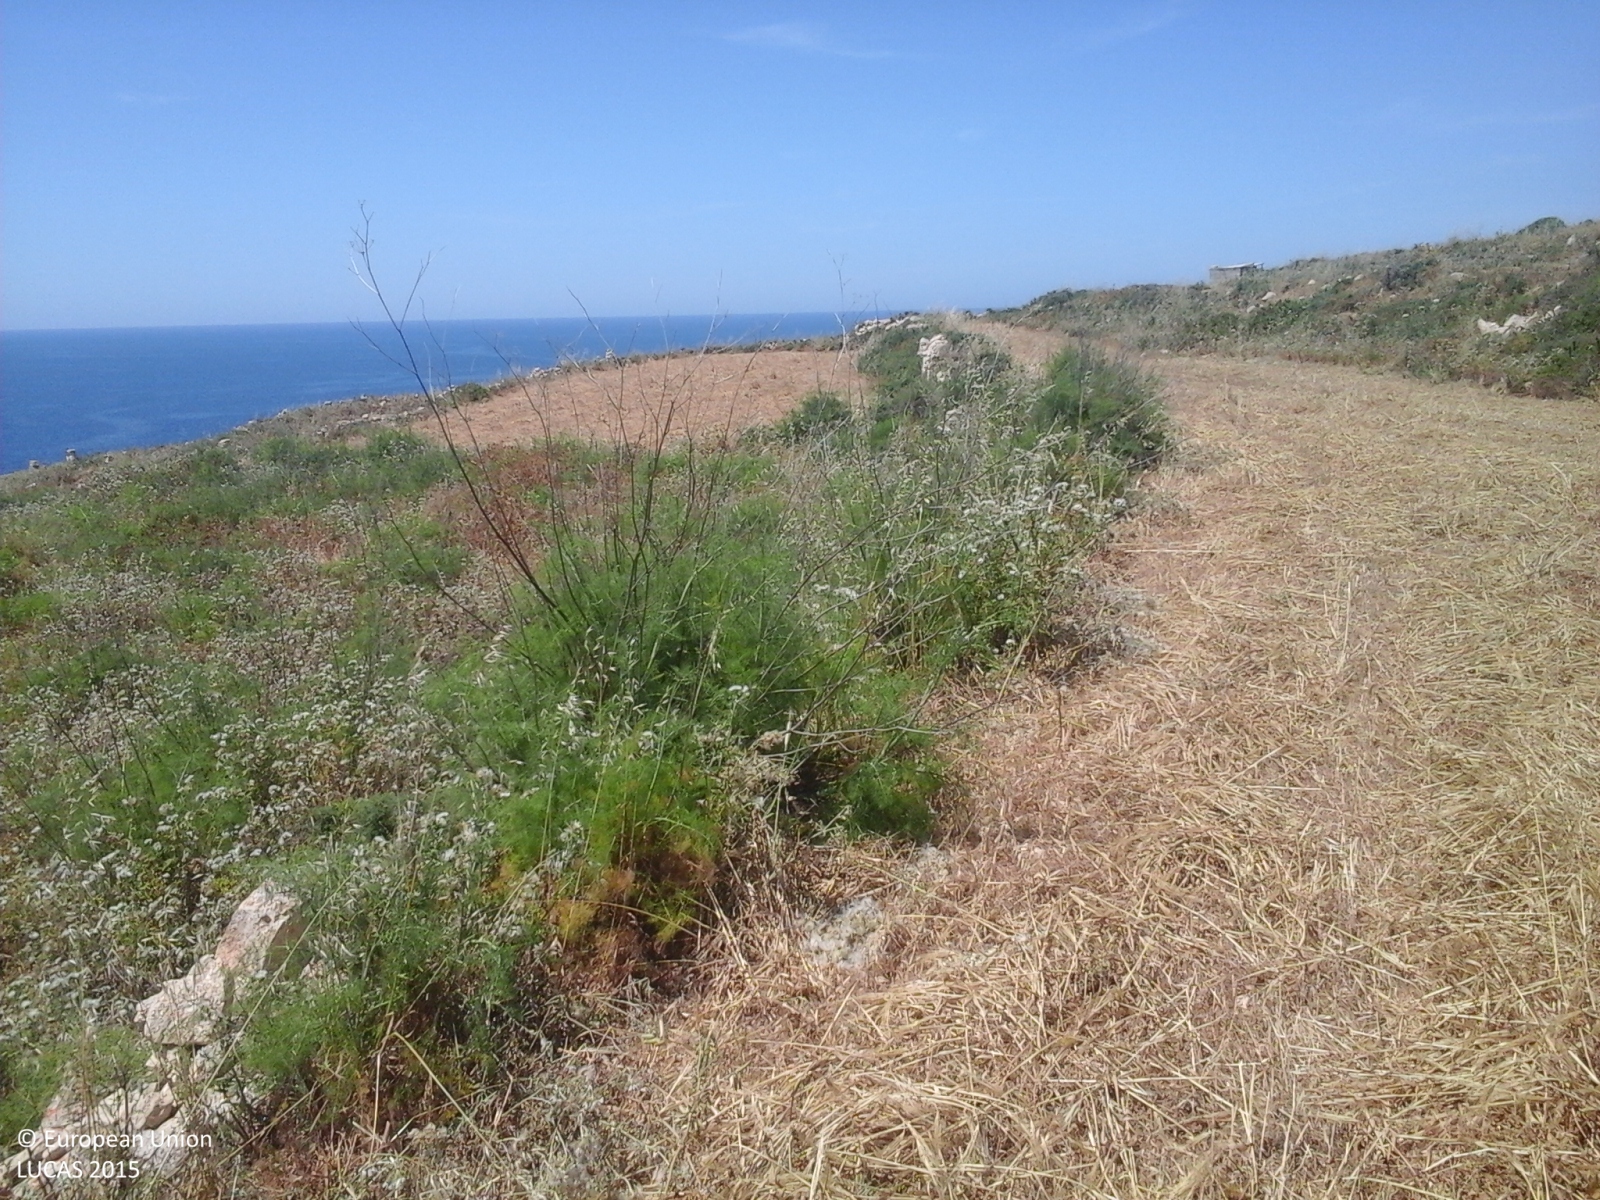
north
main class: Cropland
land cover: Mixed cereals for fodder
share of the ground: > 75 %
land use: Agriculture (excluding fallow land and kitchen gardens)
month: May
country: MT
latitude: 36.0723
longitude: 14.1923
